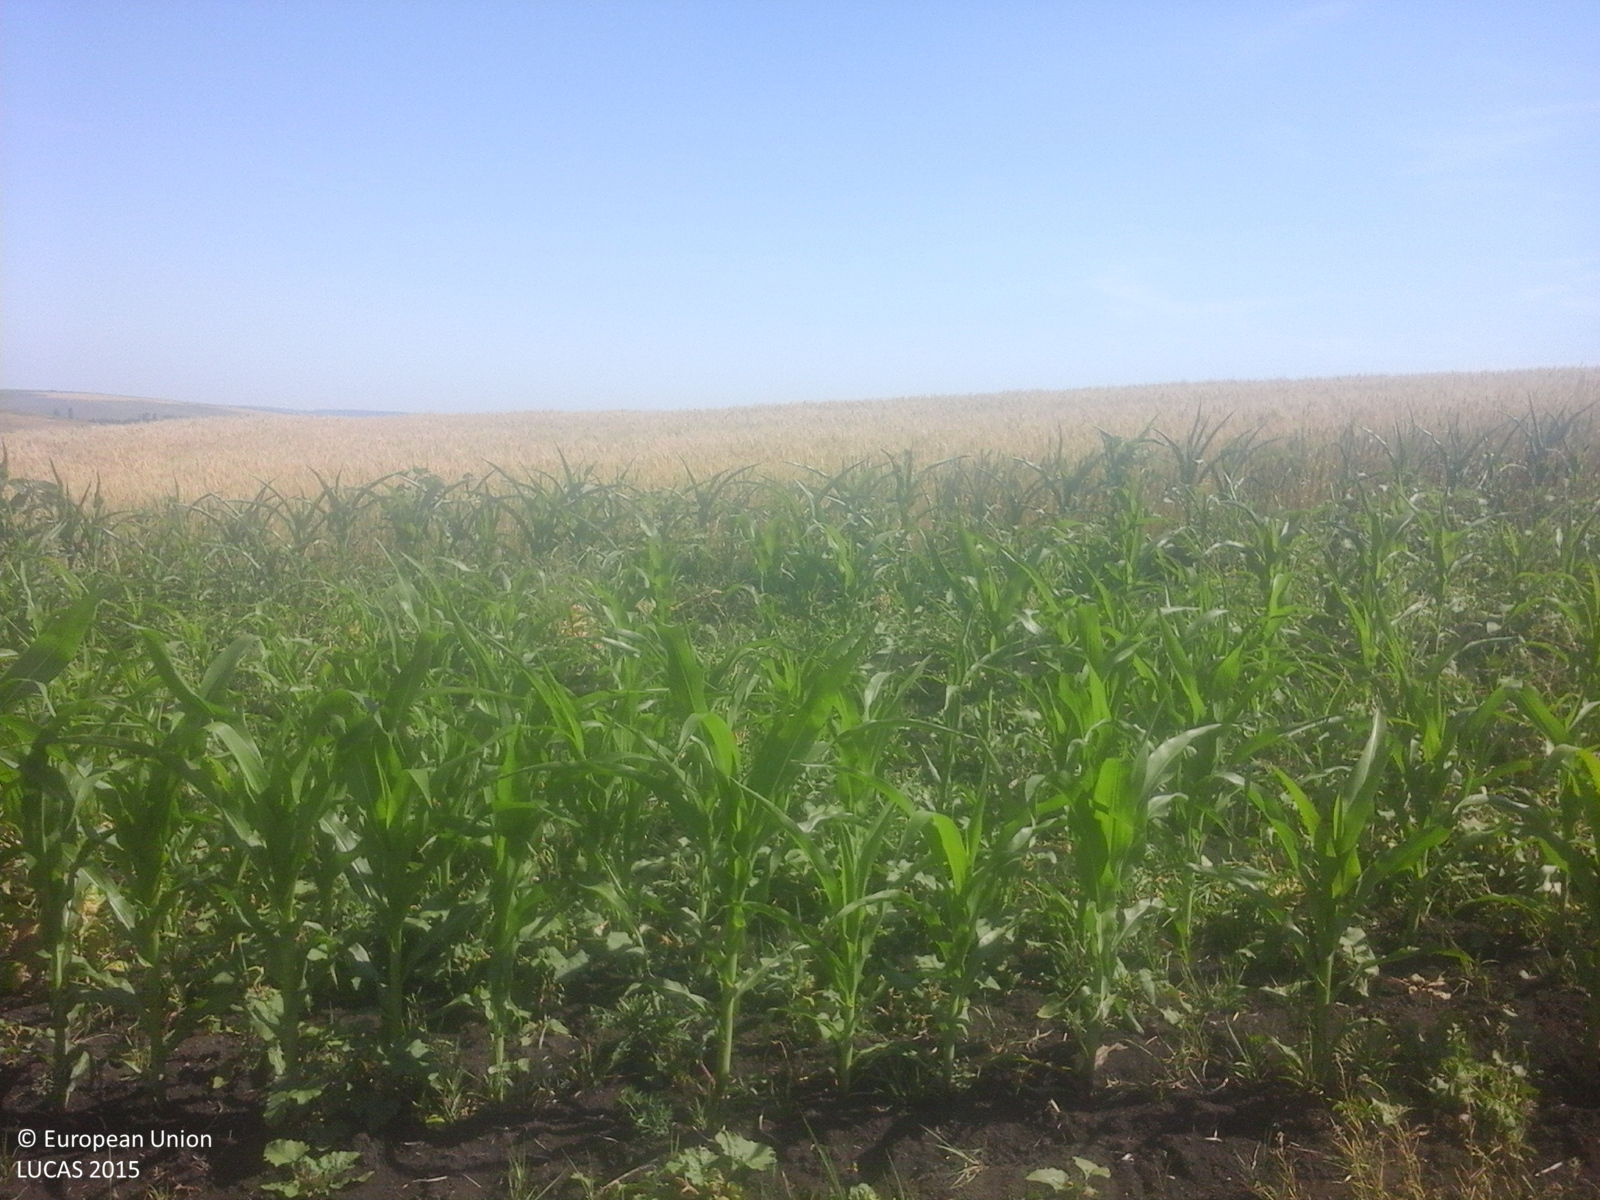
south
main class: Cropland
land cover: Maize
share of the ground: 50 - 75 %
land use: Agriculture (excluding fallow land and kitchen gardens)
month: June
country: RO
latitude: 47.9915
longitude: 26.8940
